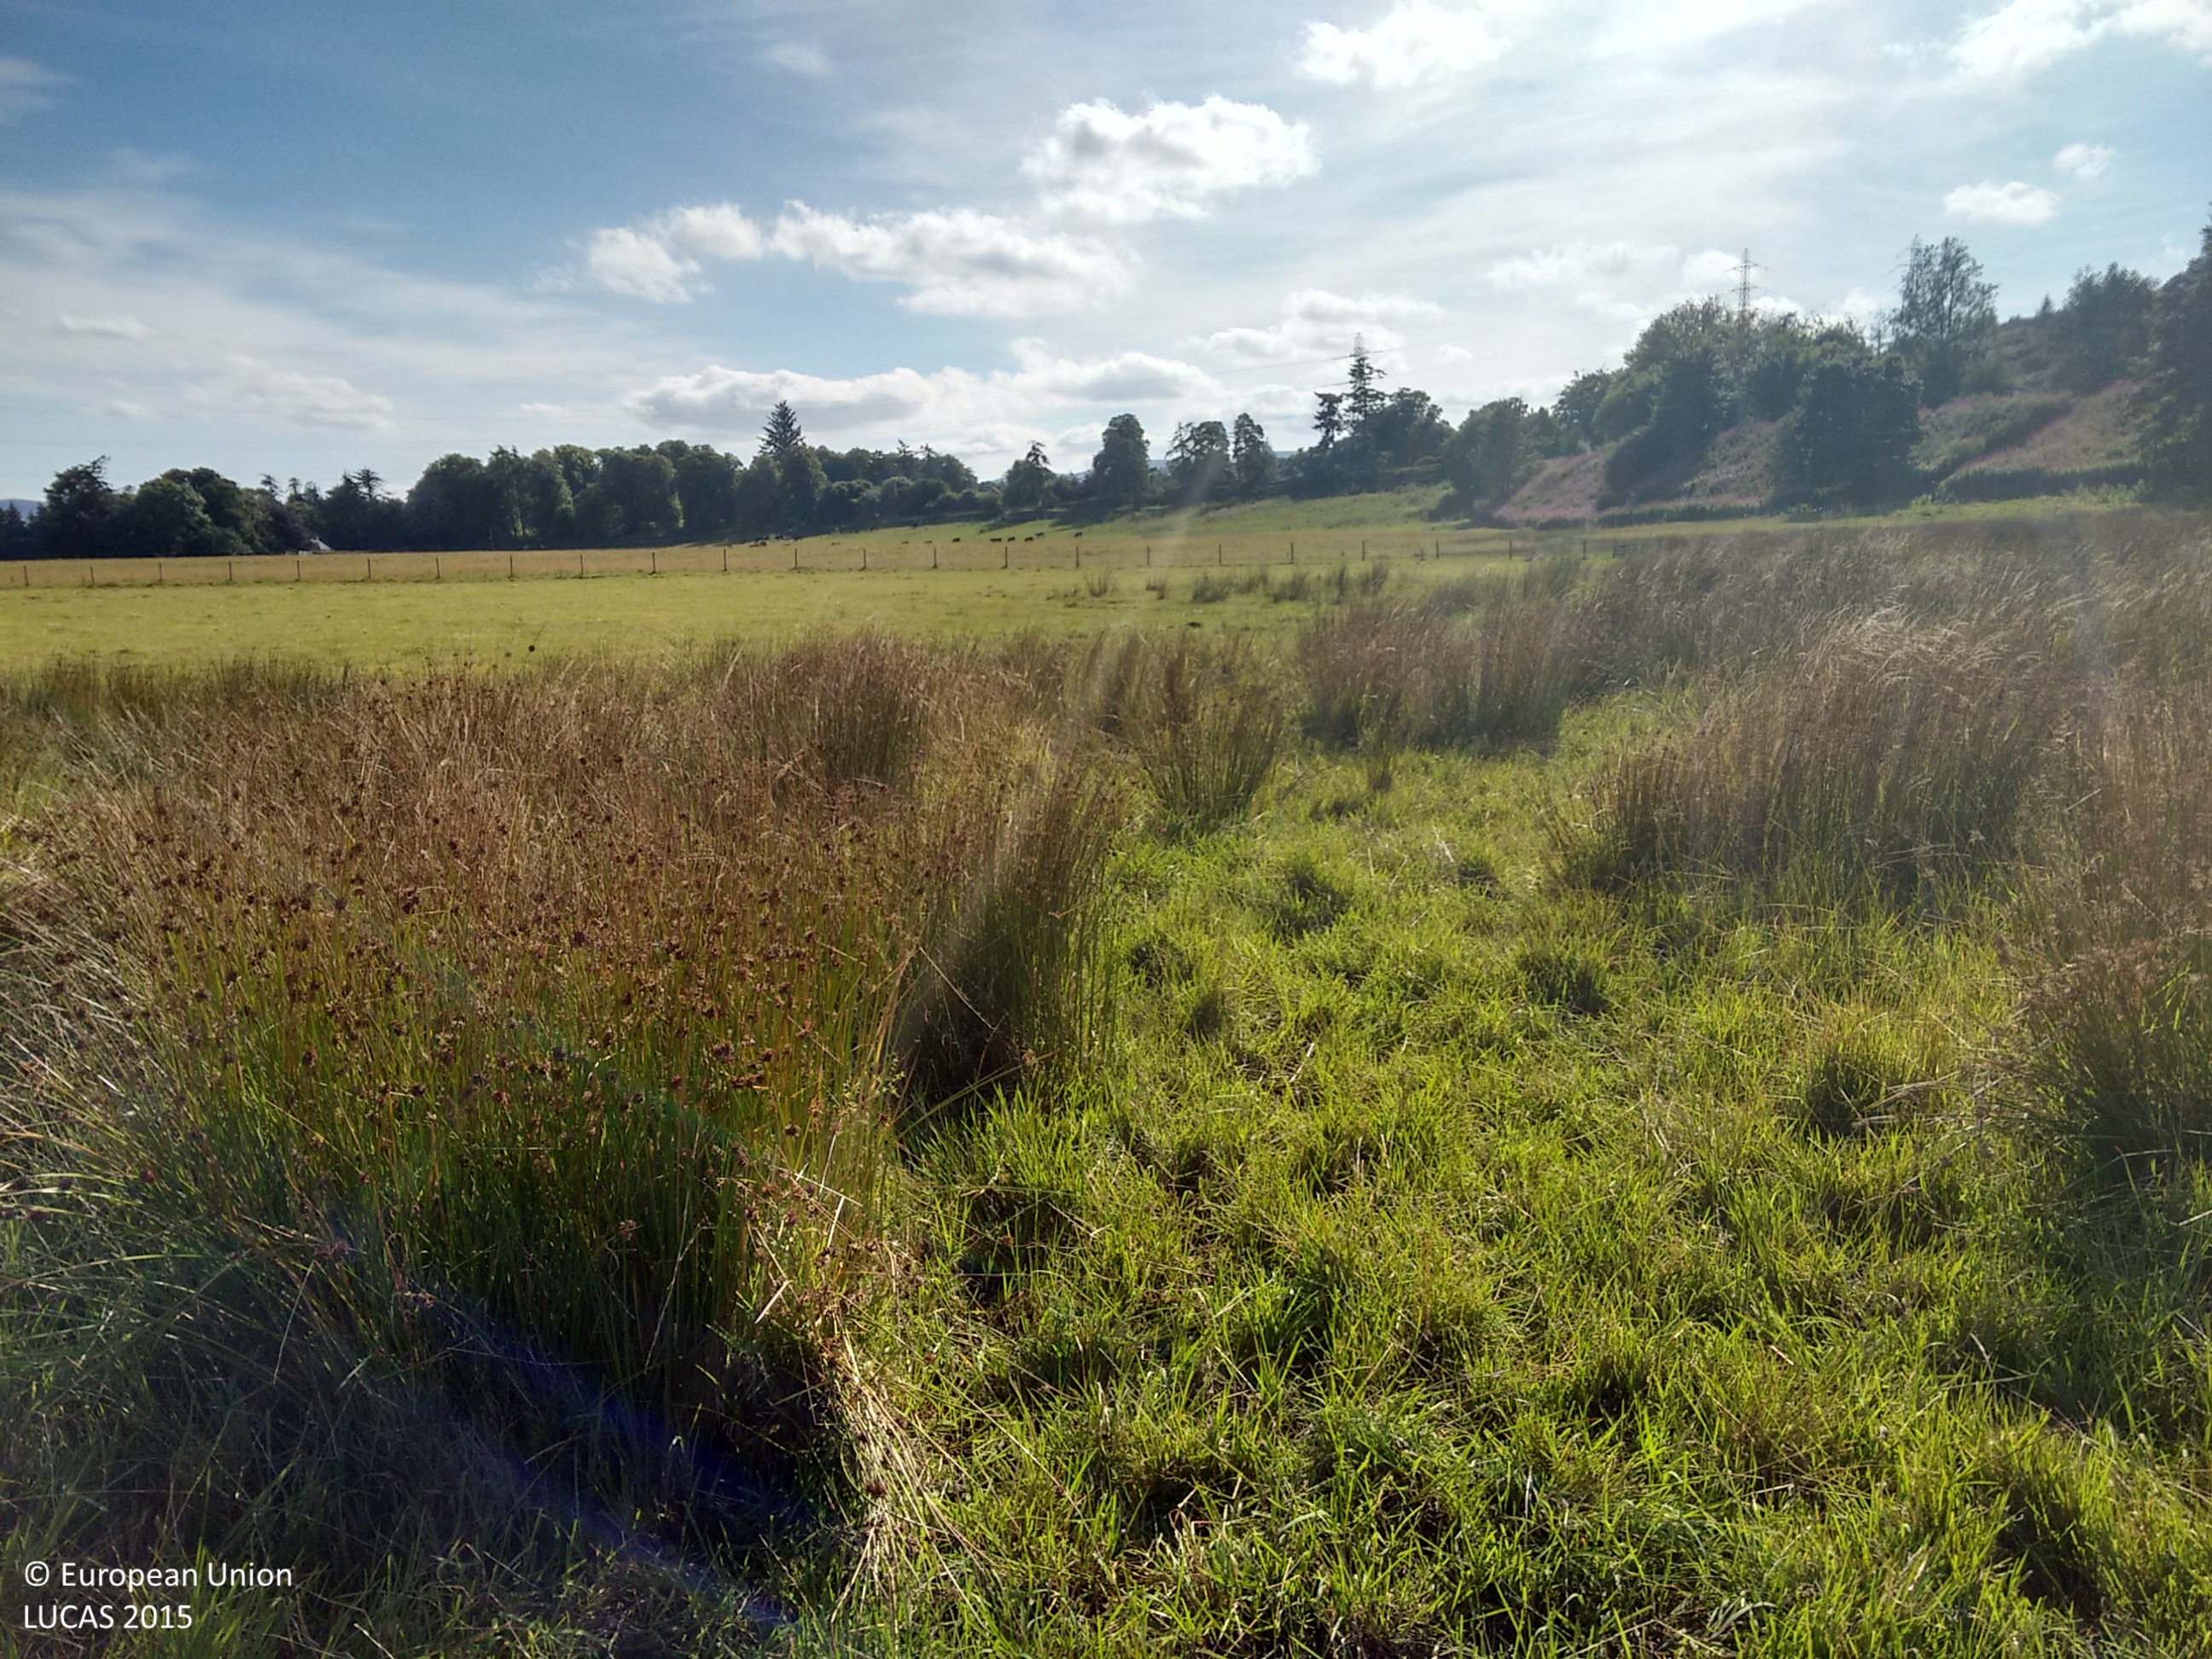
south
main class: Grassland
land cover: Grassland without tree/shrub cover
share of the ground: > 75 %
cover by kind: herbaceous plants 100 %
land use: Agriculture (excluding fallow land and kitchen gardens)
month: September
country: GB
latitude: 57.8987
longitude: -4.3763
